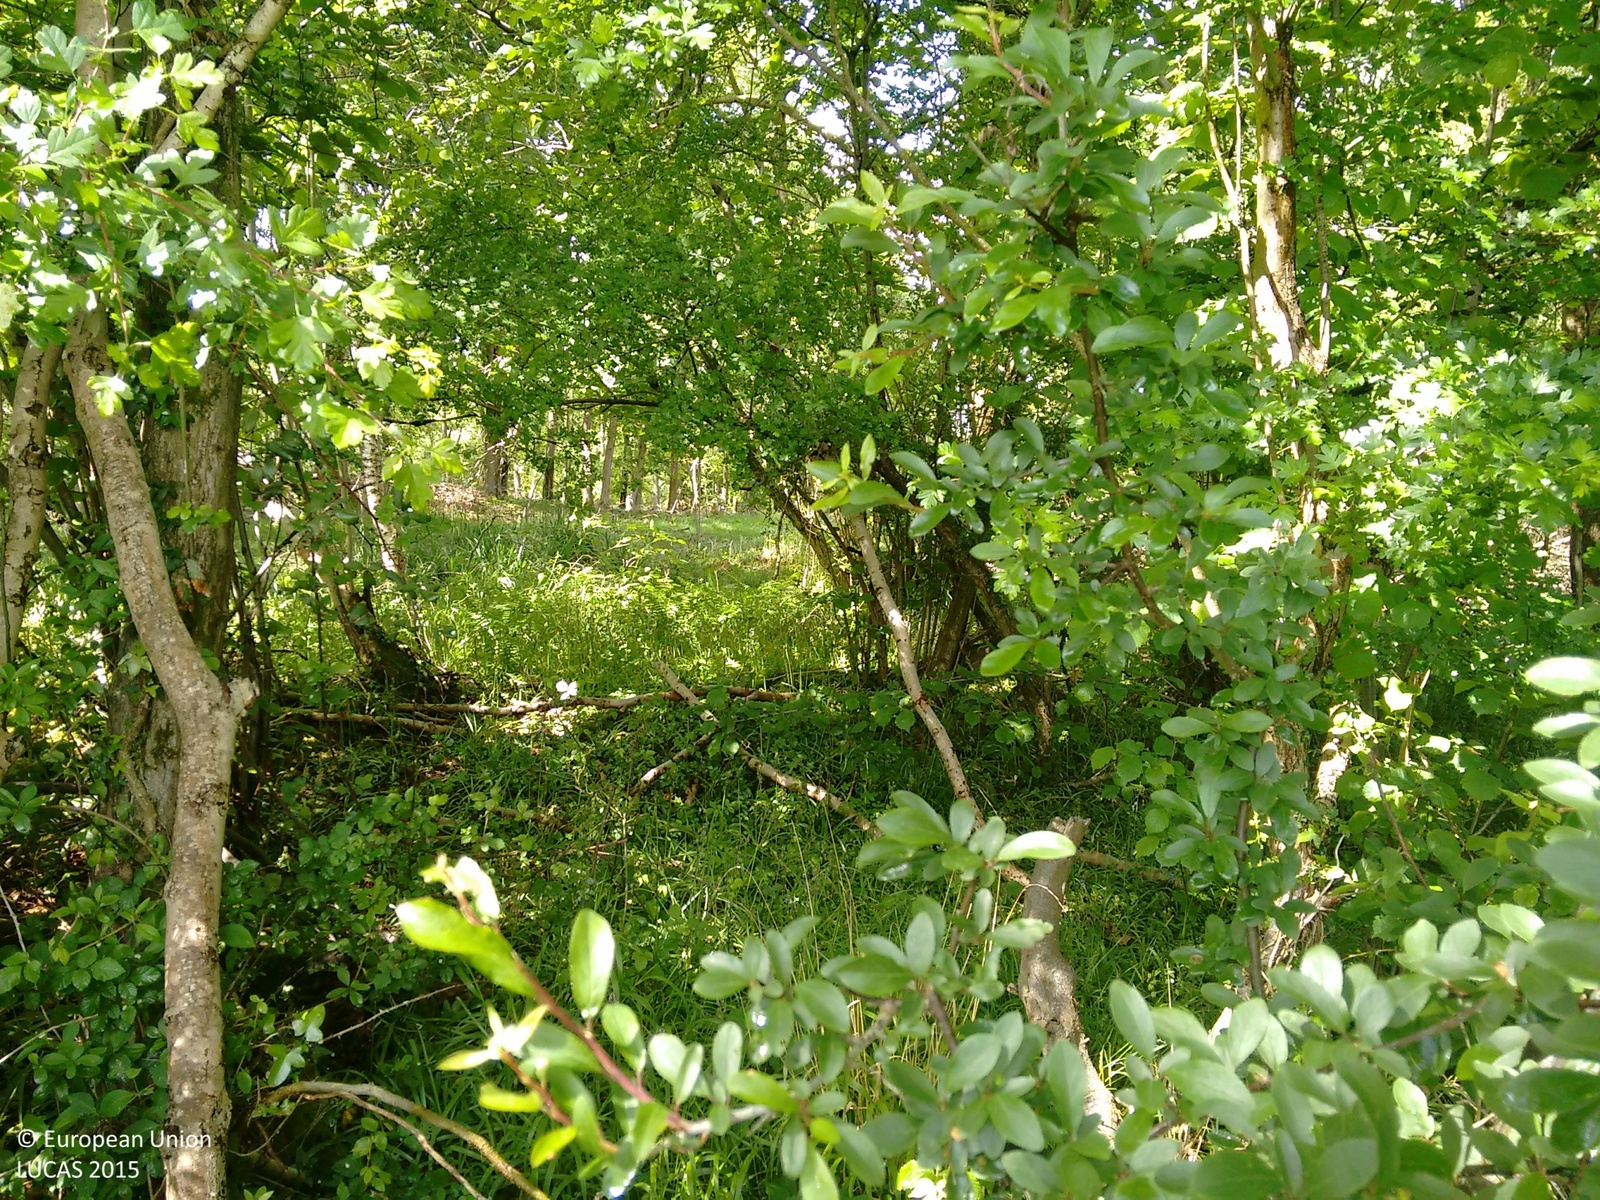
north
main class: Woodland
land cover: Broadleaved woodland
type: mesophytic deciduous forest
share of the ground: > 75 %
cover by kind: broadleaved forest trees 100 %
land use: Forestry
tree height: > 5 m
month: May
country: GB
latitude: 51.0108
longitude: -1.3806
